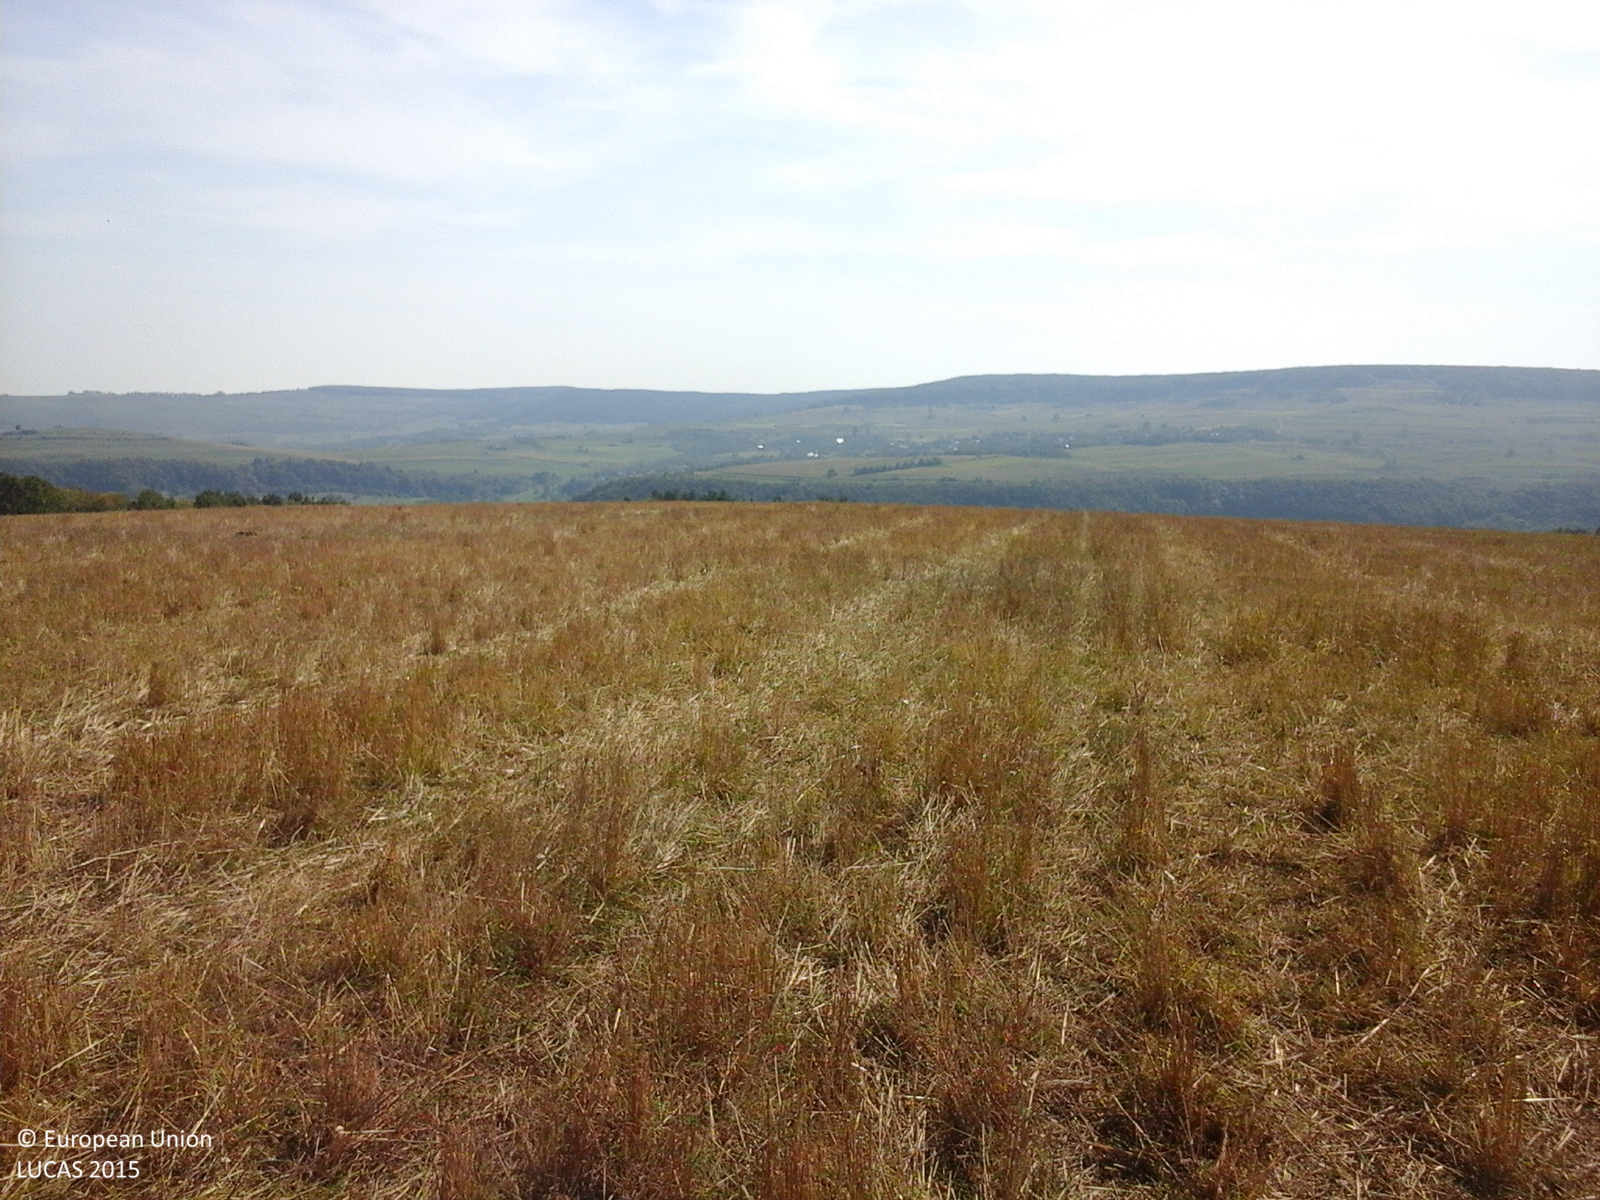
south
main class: Cropland
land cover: Common wheat
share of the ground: > 75 %
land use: Agriculture (excluding fallow land and kitchen gardens)
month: September
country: RO
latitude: 47.1203
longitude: 23.7444
